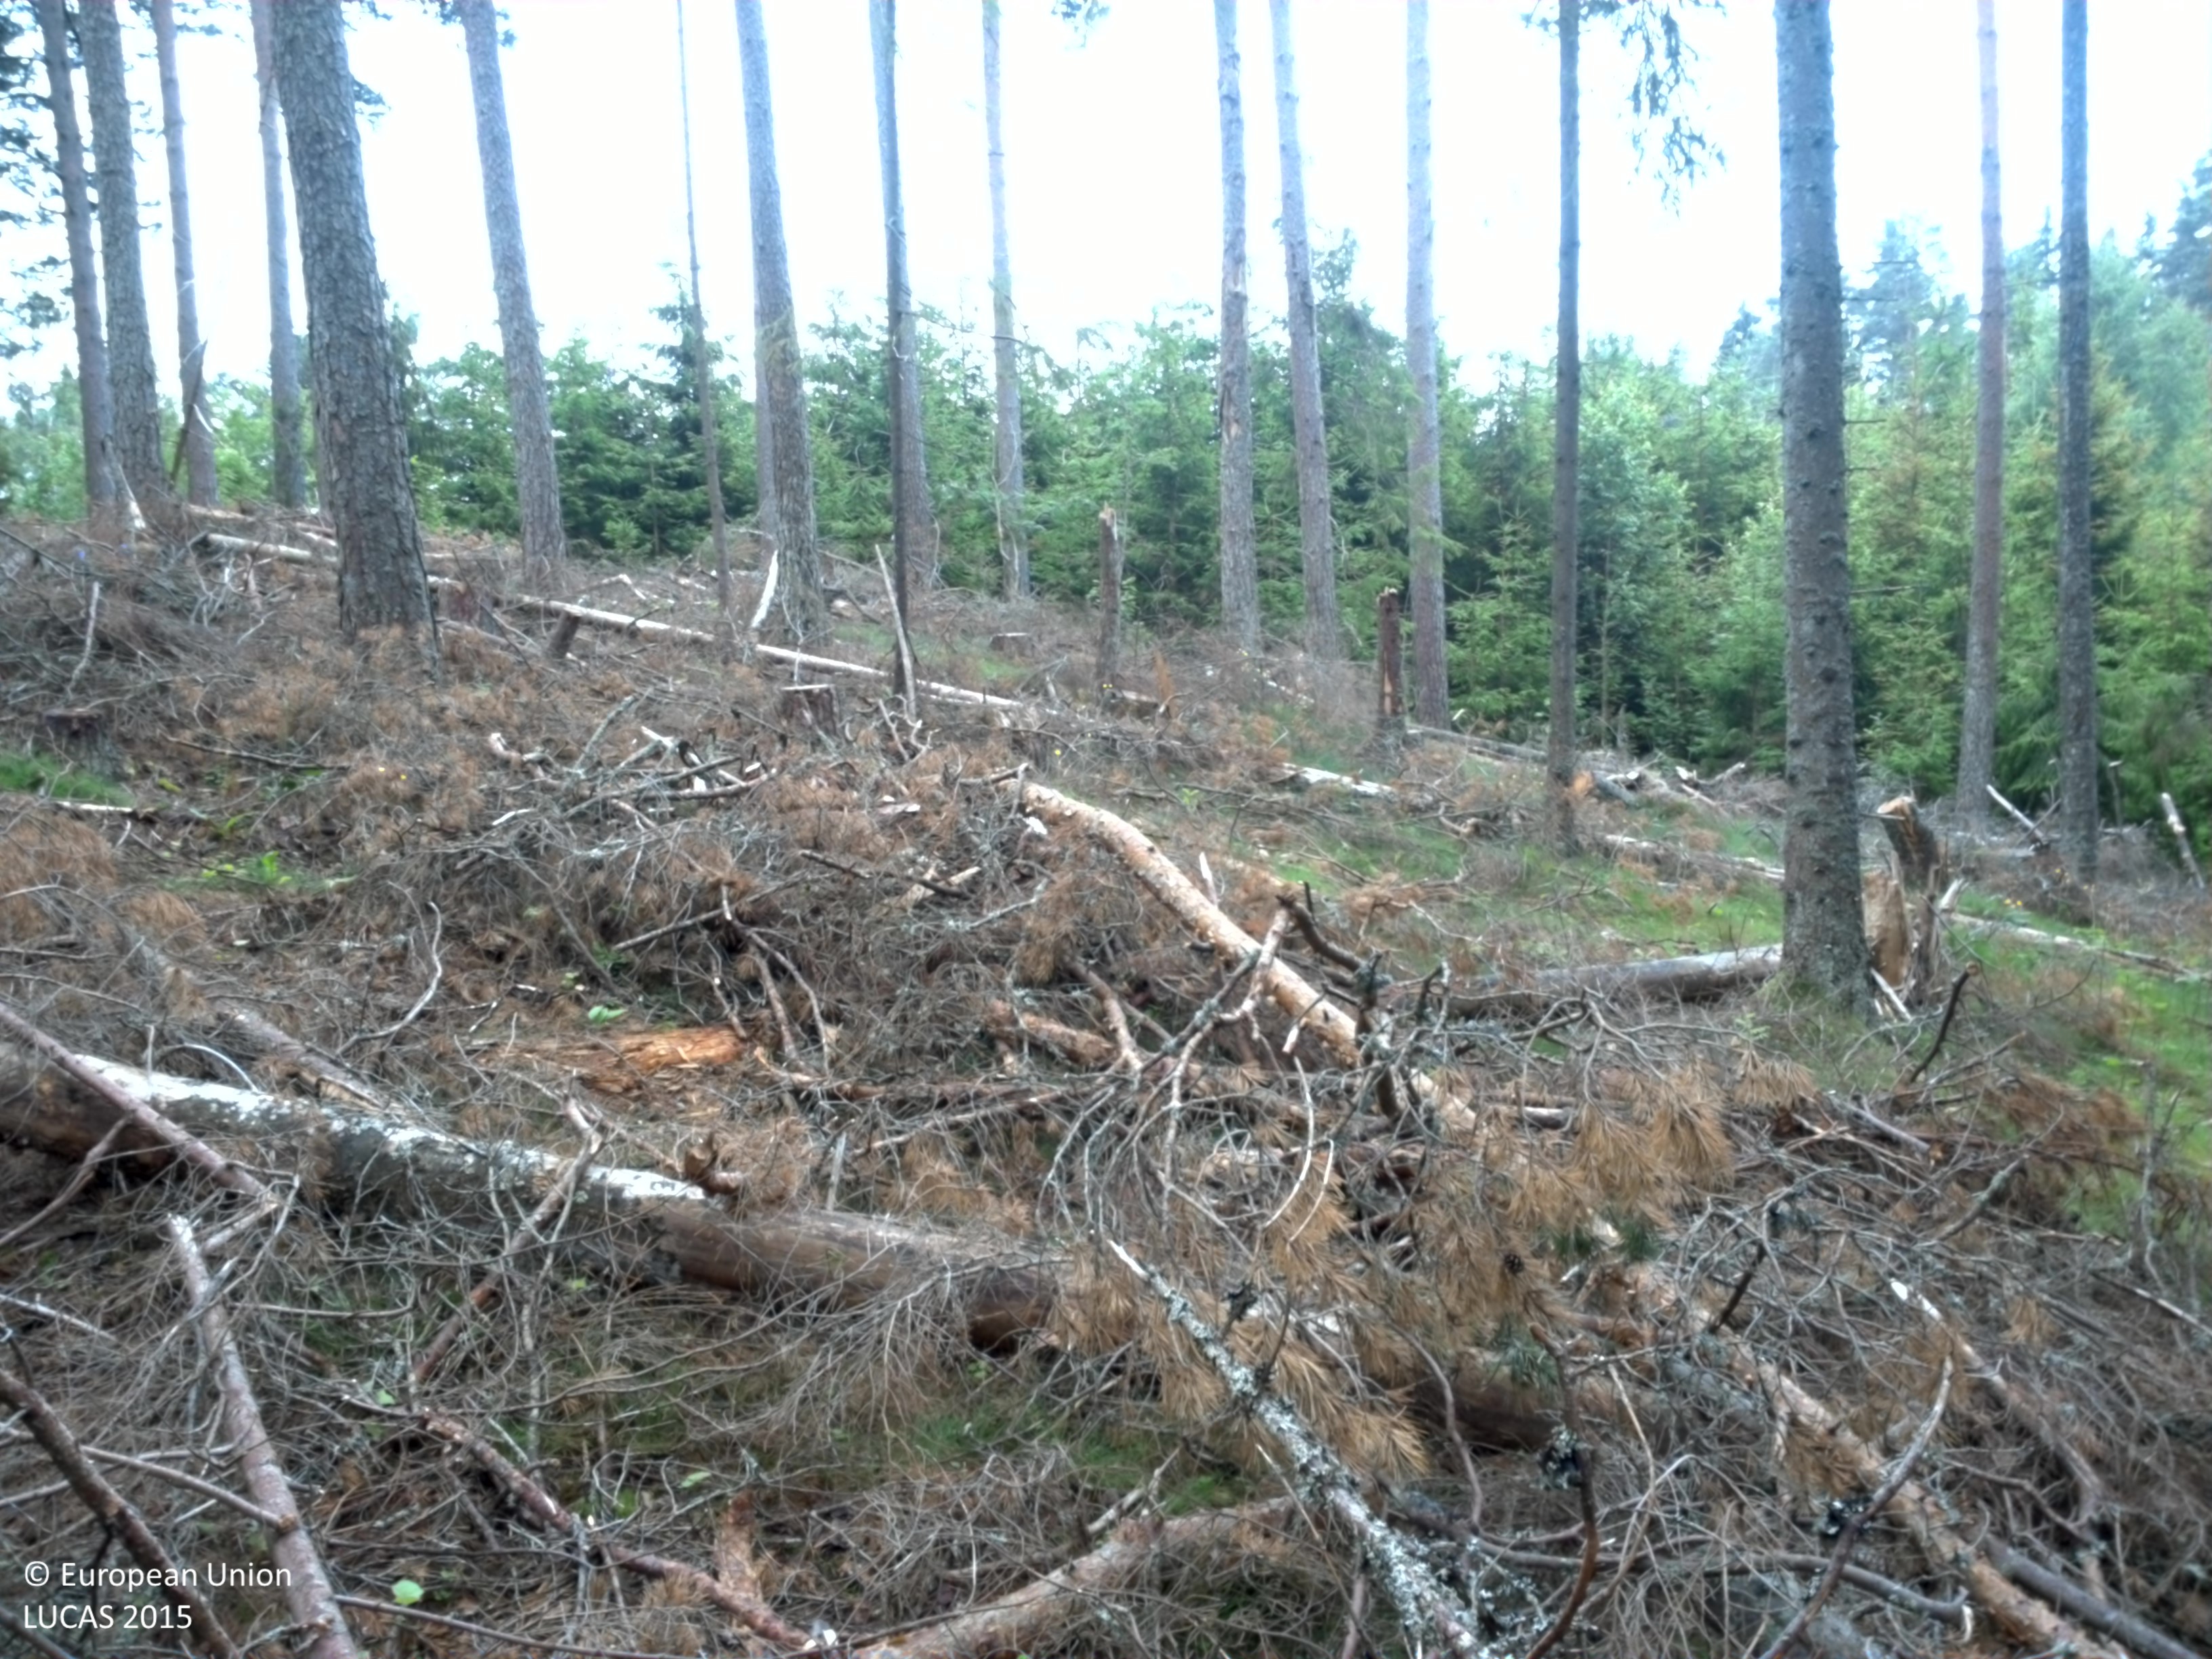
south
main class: Woodland
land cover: Pine dominated coniferous woodland
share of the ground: 50 - 75 %
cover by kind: coniferous forest trees 50 %, unconsolidated bare surface 35 %, herbaceous plants 15 %
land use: Forestry
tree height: > 5 m
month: July
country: SE
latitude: 57.7294
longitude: 14.5124
